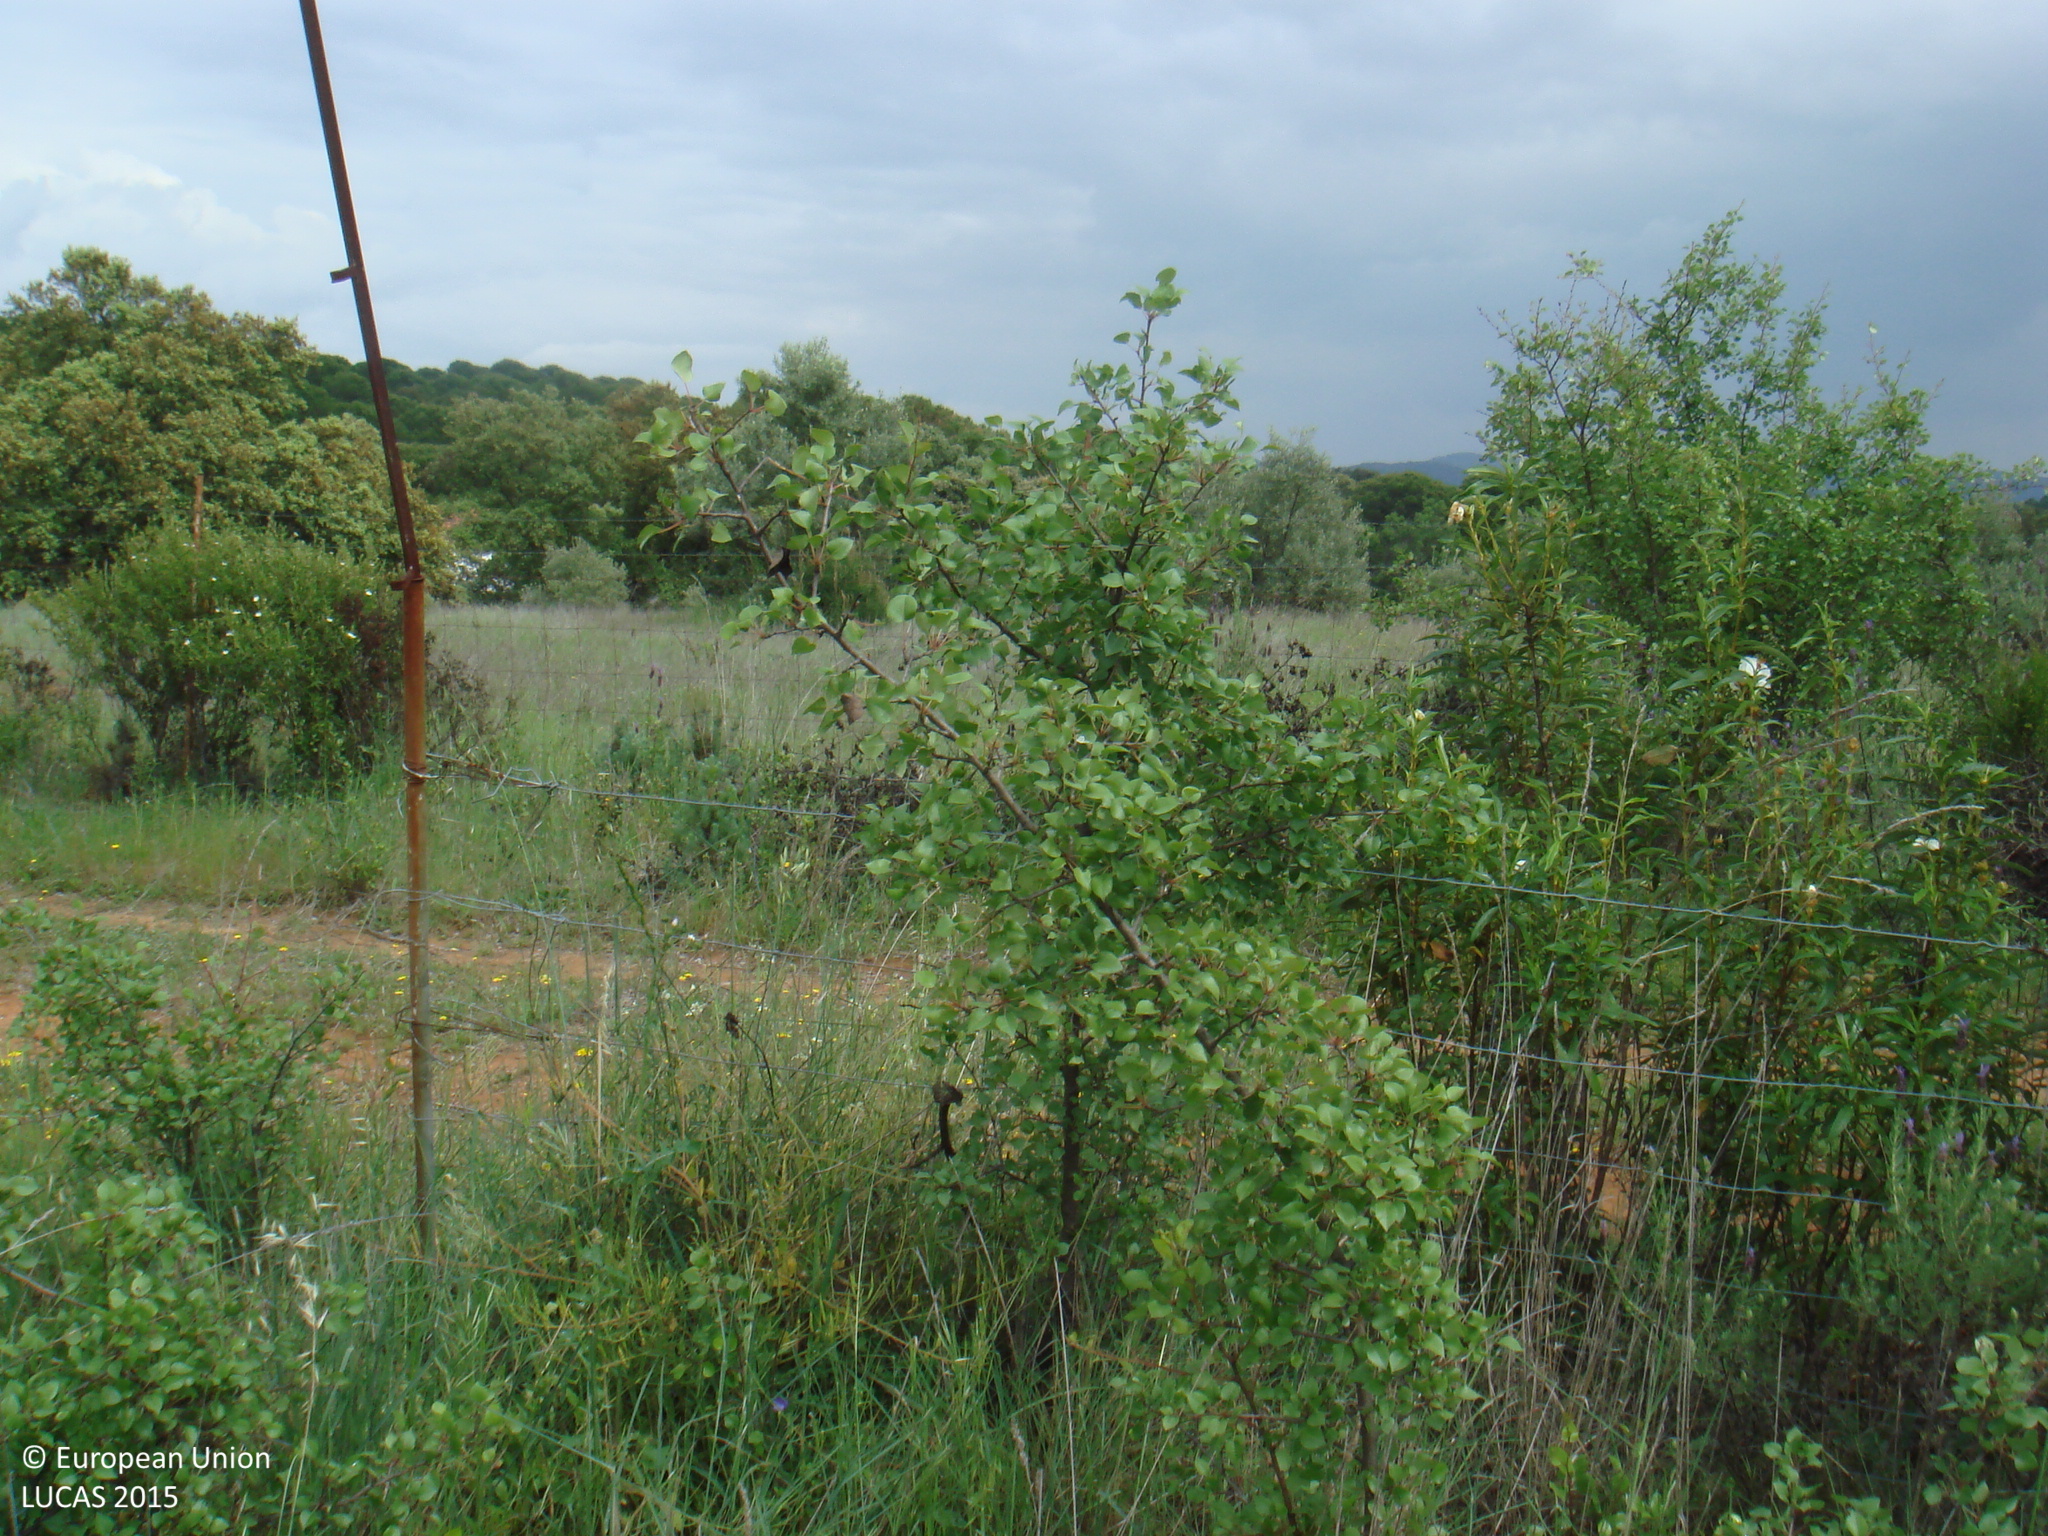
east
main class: Shrubland
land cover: Shrubland without tree cover
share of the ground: 50 - 75 %
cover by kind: shrubs 50 %, herbaceous plants 40 %, unconsolidated bare surface 10 %
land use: Semi-natural and natural areas not in use
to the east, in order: Shrubland without tree cover; Fences; Grass margins; Tracks; Grass margins; Fences; Grassland without tree/shrub cover; Olive groves; Fences; Broadleaved woodland; Tracks; Shrubland with sparse tree cover; Broadleaved woodland; Pine dominated mixed woodland
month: April
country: ES
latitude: 38.0225
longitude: -4.9995
